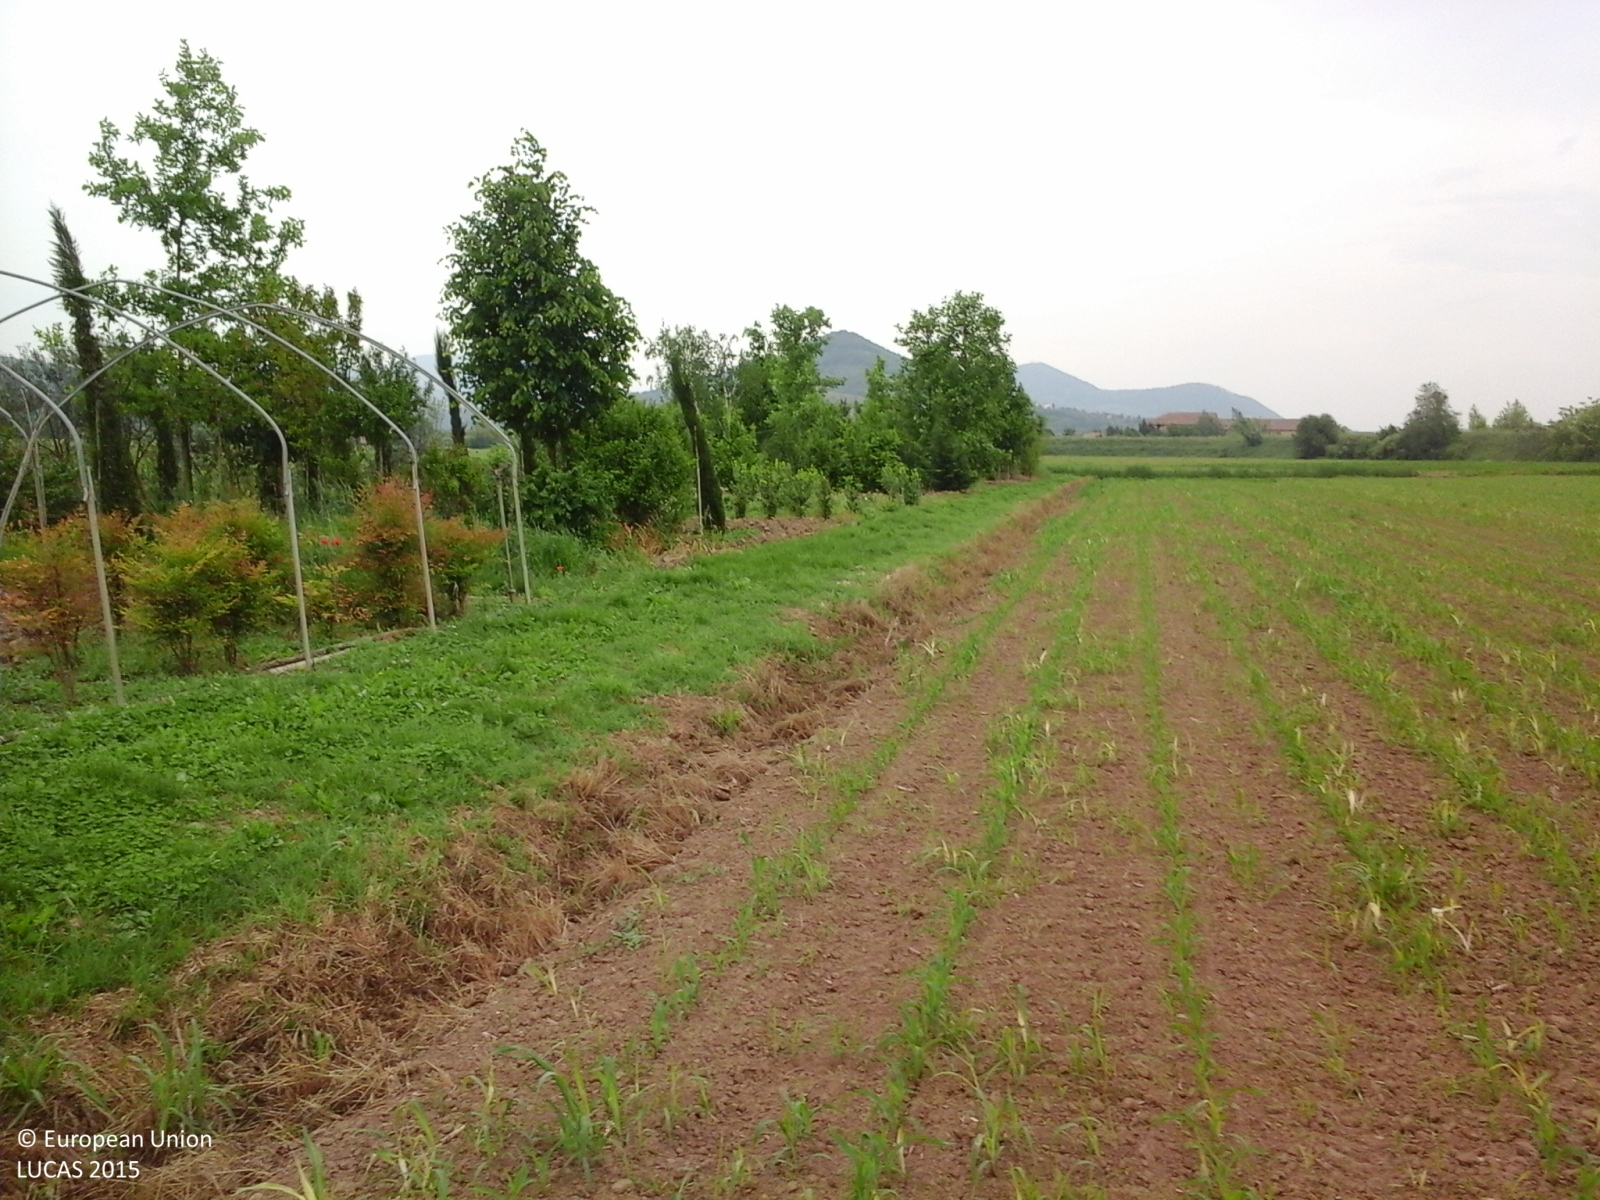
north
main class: Cropland
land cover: Maize
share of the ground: 10 - 25 %
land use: Agriculture (excluding fallow land and kitchen gardens)
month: May
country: IT
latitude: 45.2205
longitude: 11.6907
